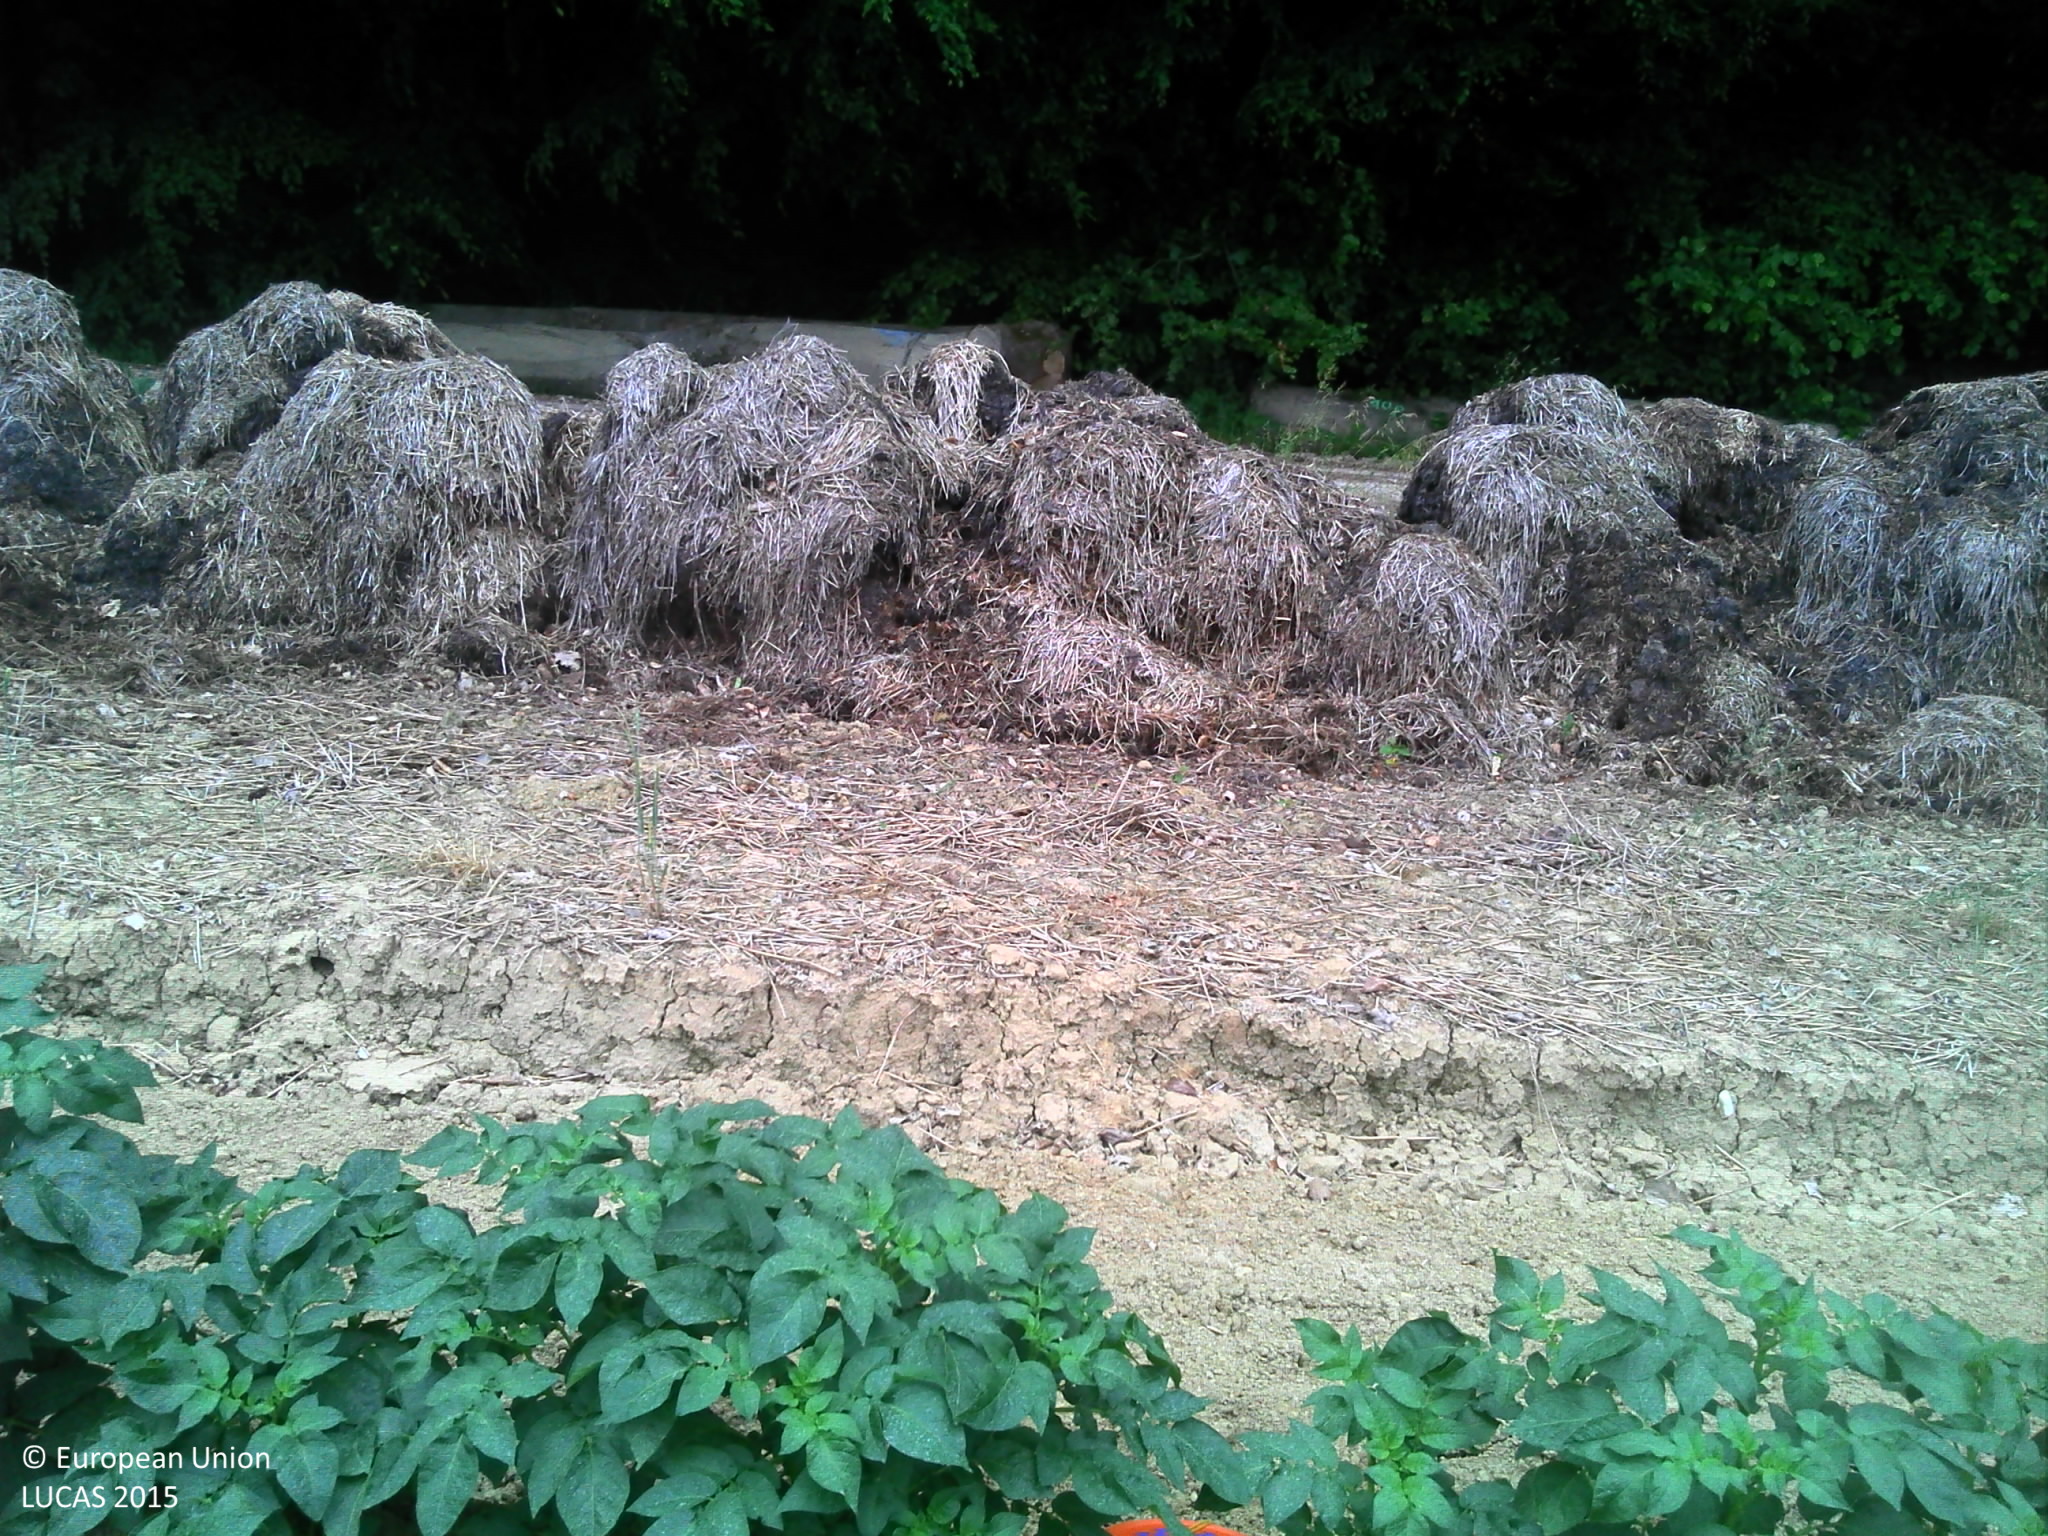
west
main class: Cropland
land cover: Potatoes
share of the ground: 50 - 75 %
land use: Agriculture (excluding fallow land and kitchen gardens)
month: June
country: FR
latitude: 47.5108
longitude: 7.4921
